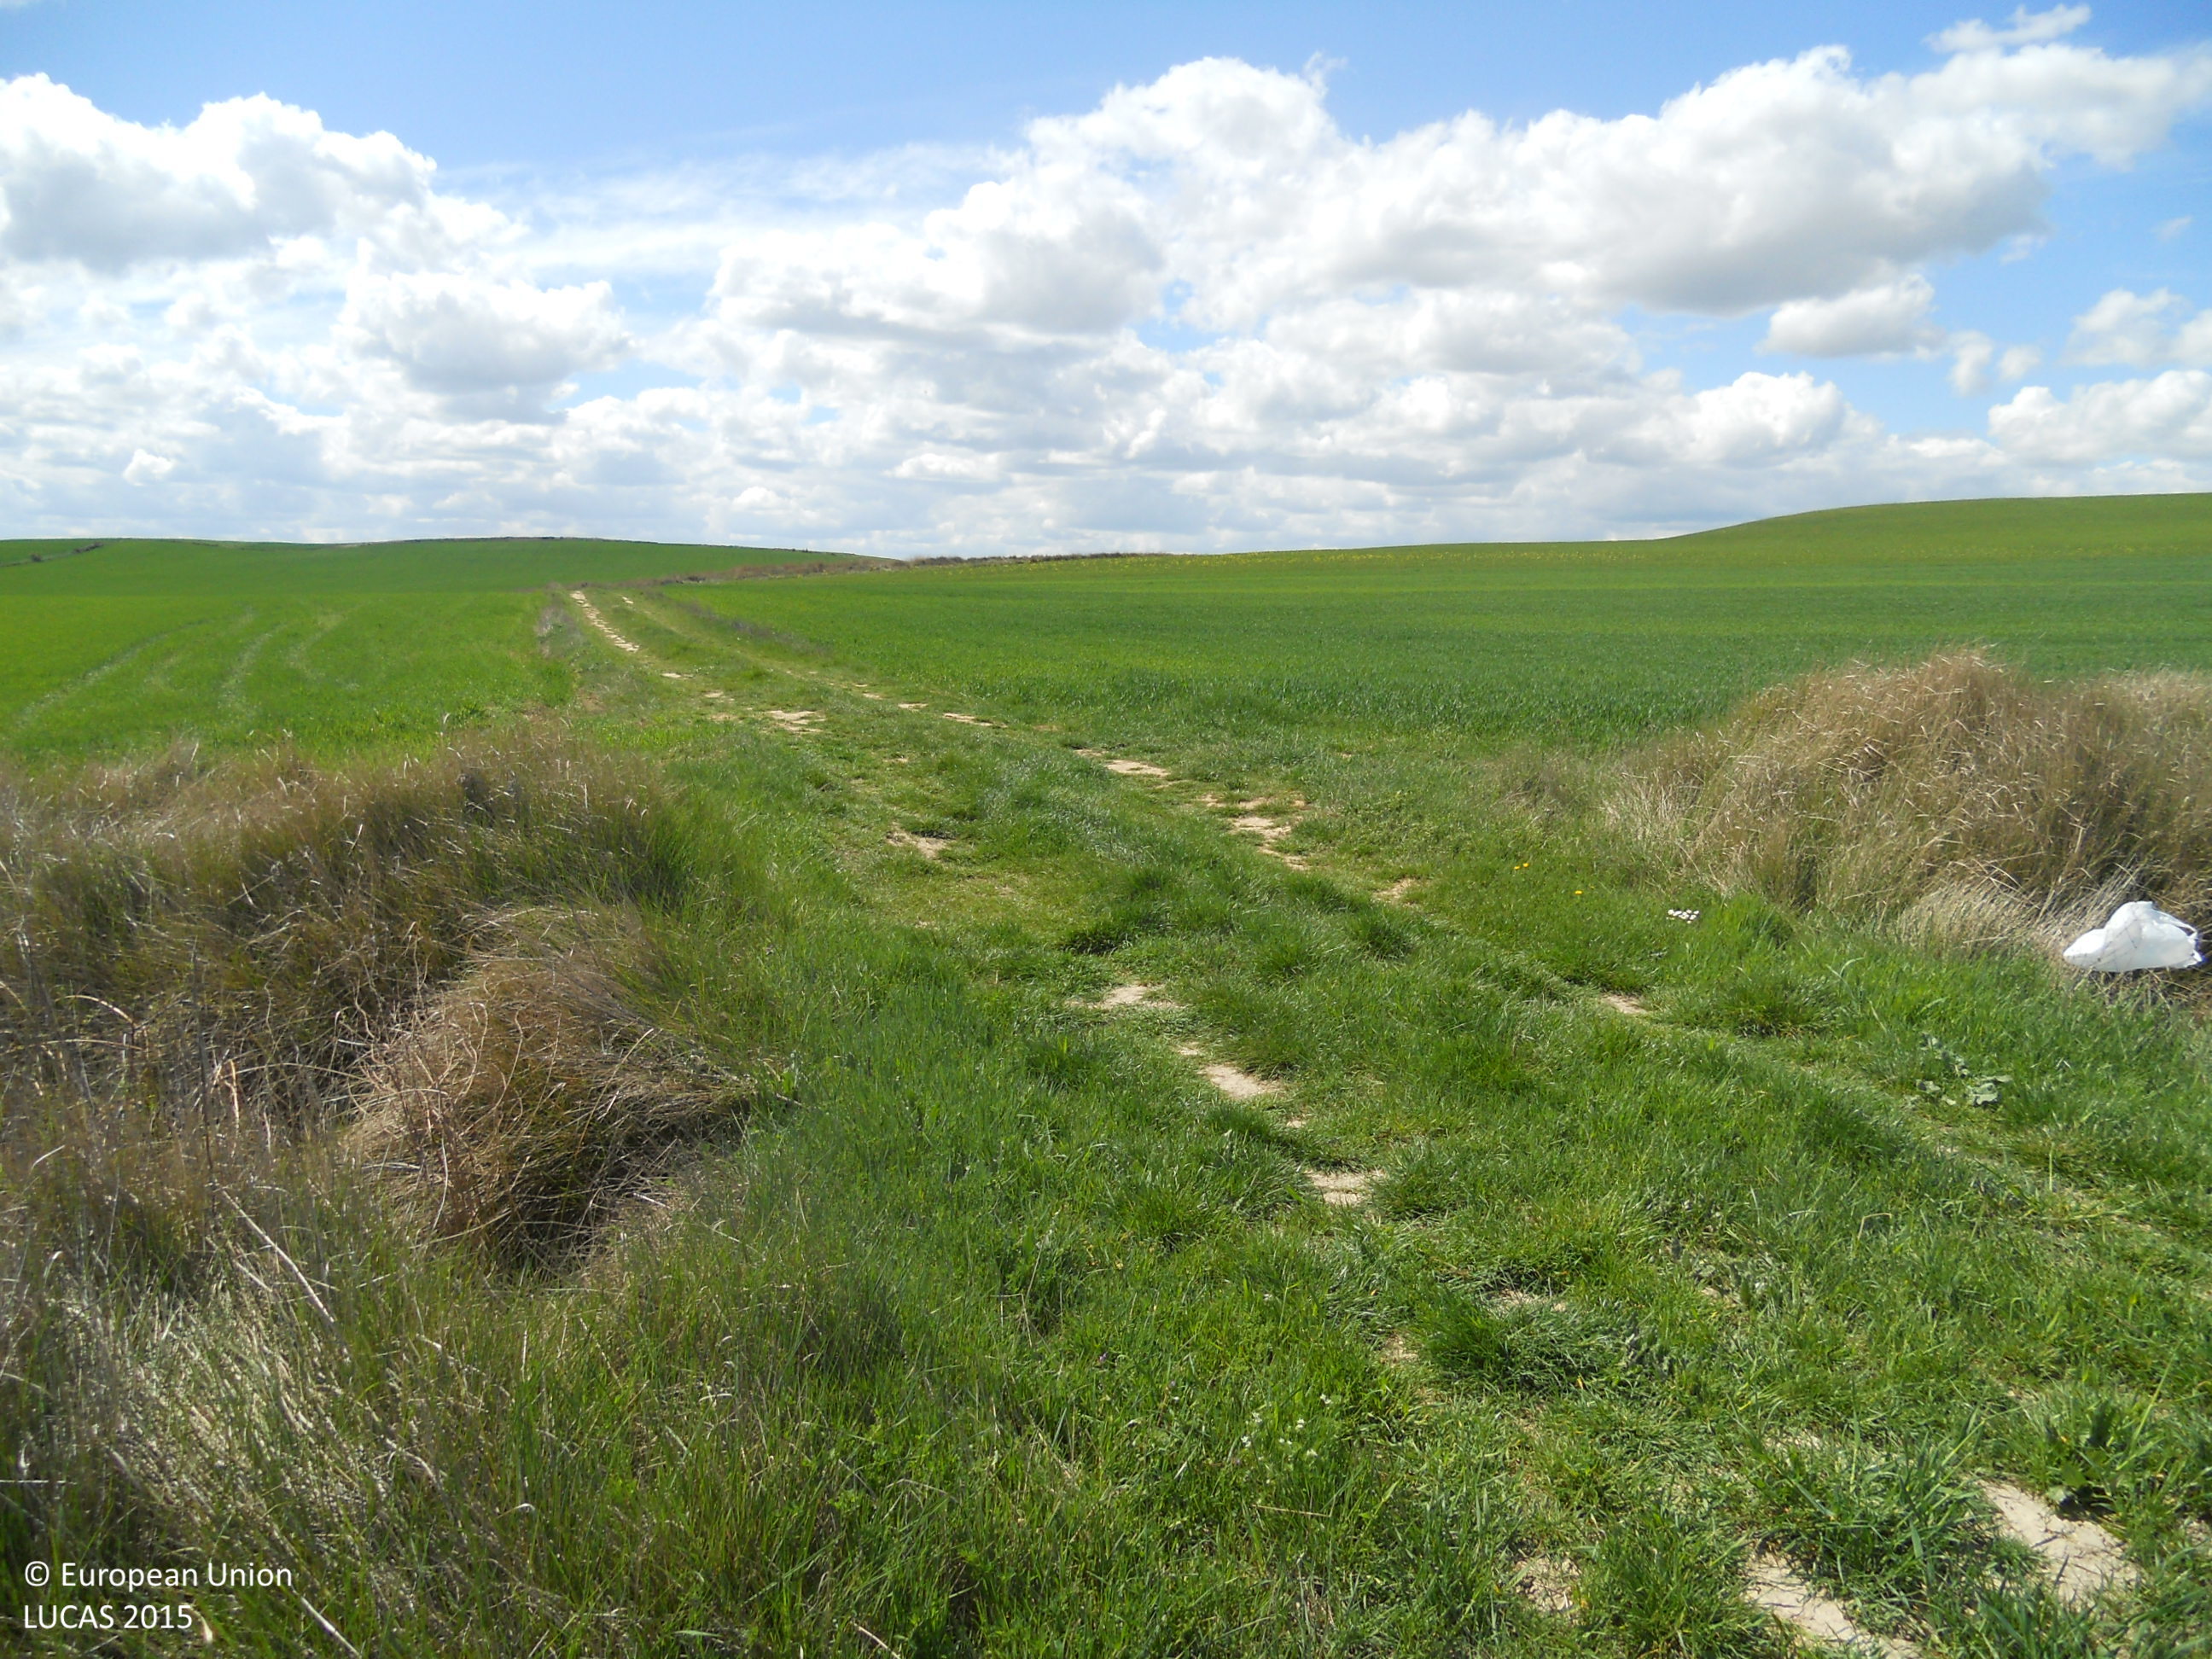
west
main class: Cropland
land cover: Barley
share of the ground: > 75 %
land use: Agriculture (excluding fallow land and kitchen gardens)
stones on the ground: < 10 %
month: April
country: ES
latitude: 42.3034
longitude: -4.2248
